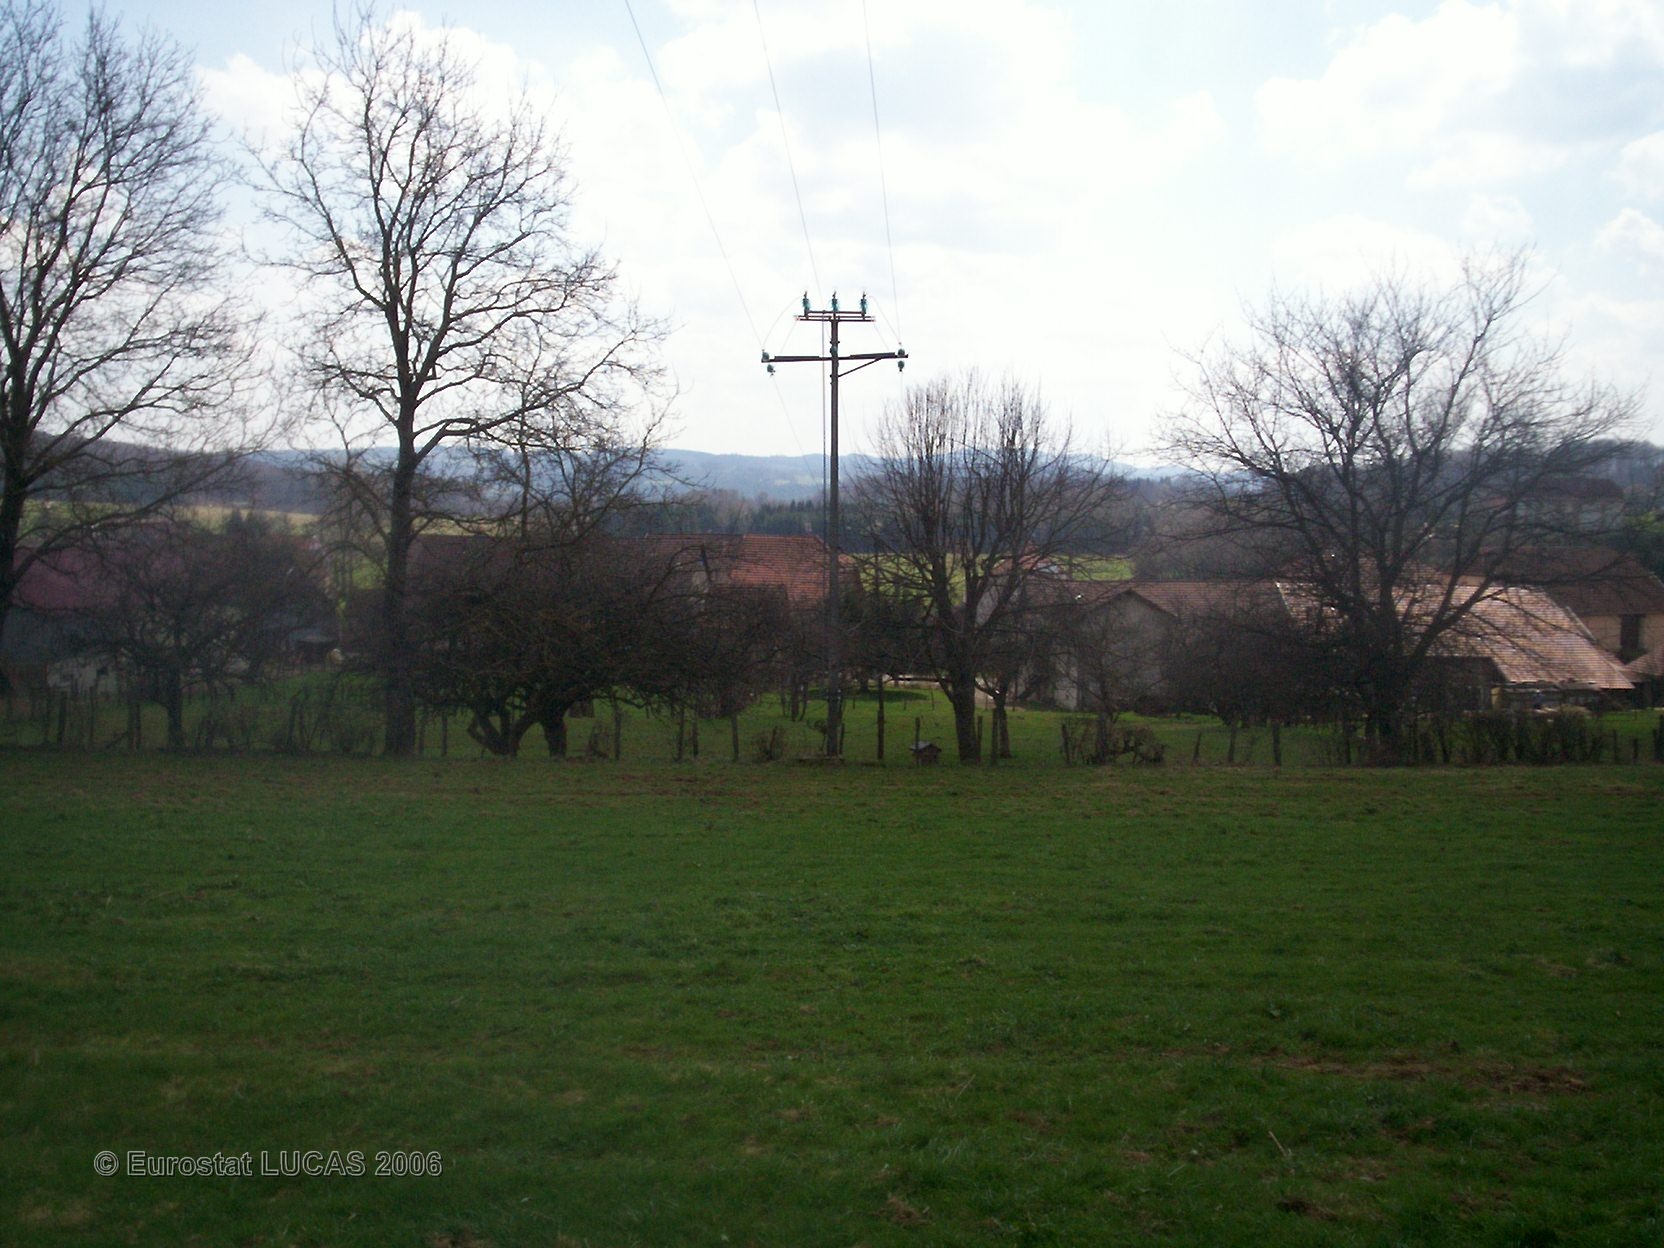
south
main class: Grassland
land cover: Grassland without tree/shrub cover
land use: Agriculture (excluding fallow land and kitchen gardens)
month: April
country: FR
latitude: 47.3497
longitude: 6.8381
